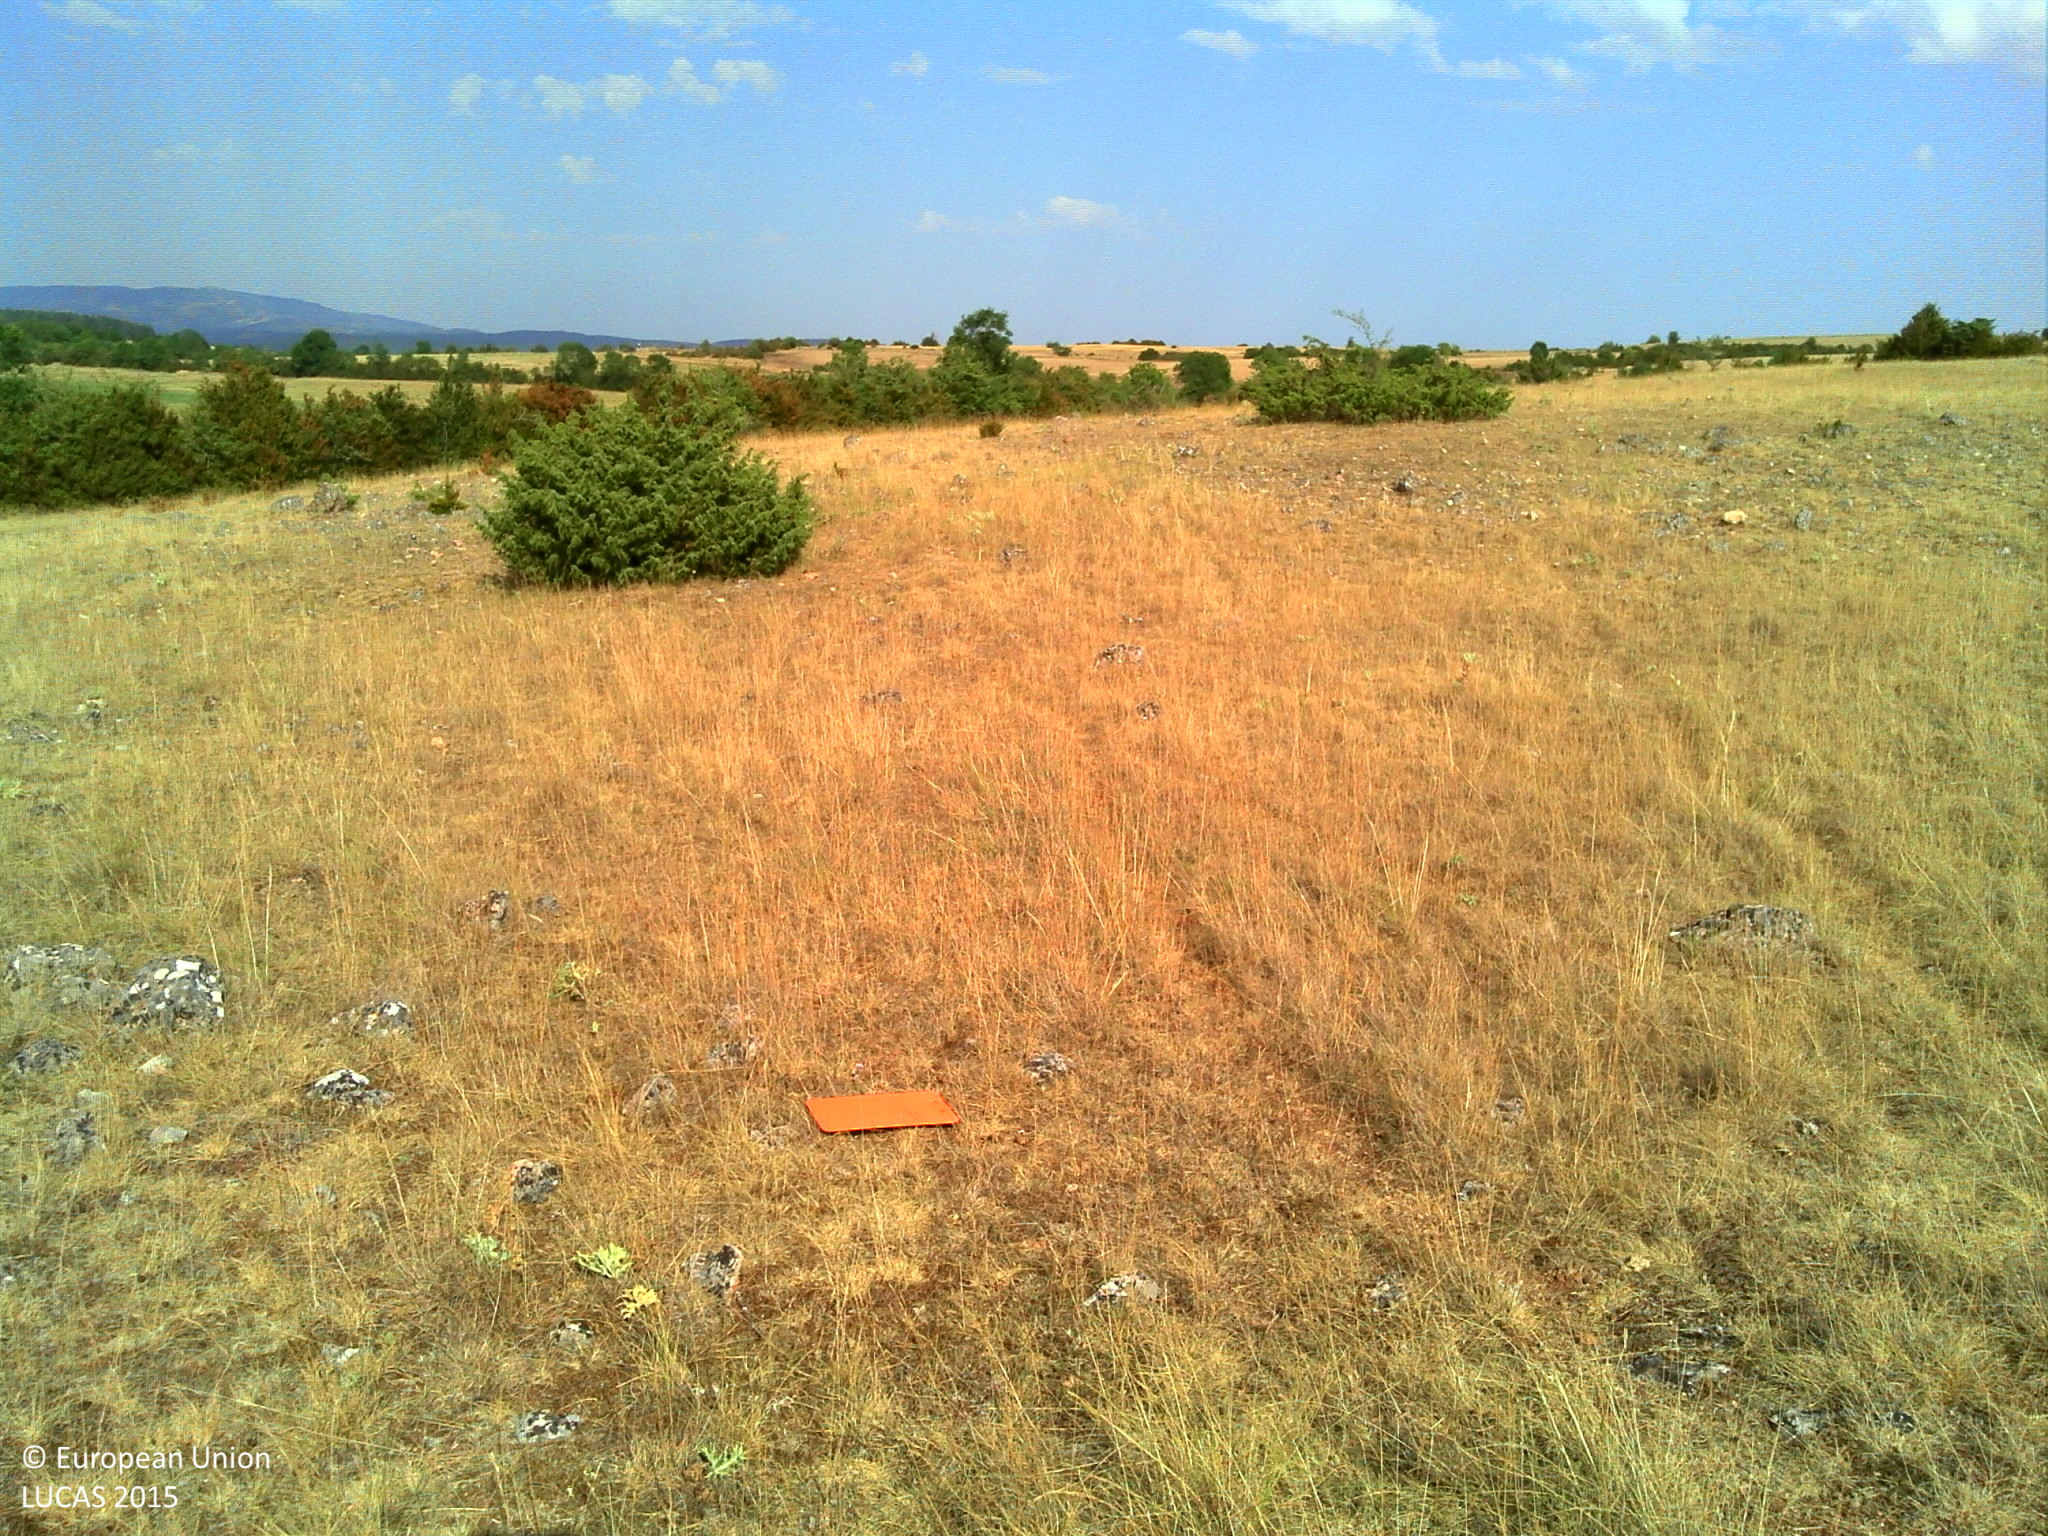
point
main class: Grassland
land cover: Grassland with sparse tree/shrub cover
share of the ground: > 75 %
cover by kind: herbaceous plants 85 %, broadleaved forest trees 5 %, shrubs 5 %, consolidated bare surface 5 %
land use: Agriculture (excluding fallow land and kitchen gardens)
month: August
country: FR
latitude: 43.9622
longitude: 3.1645
